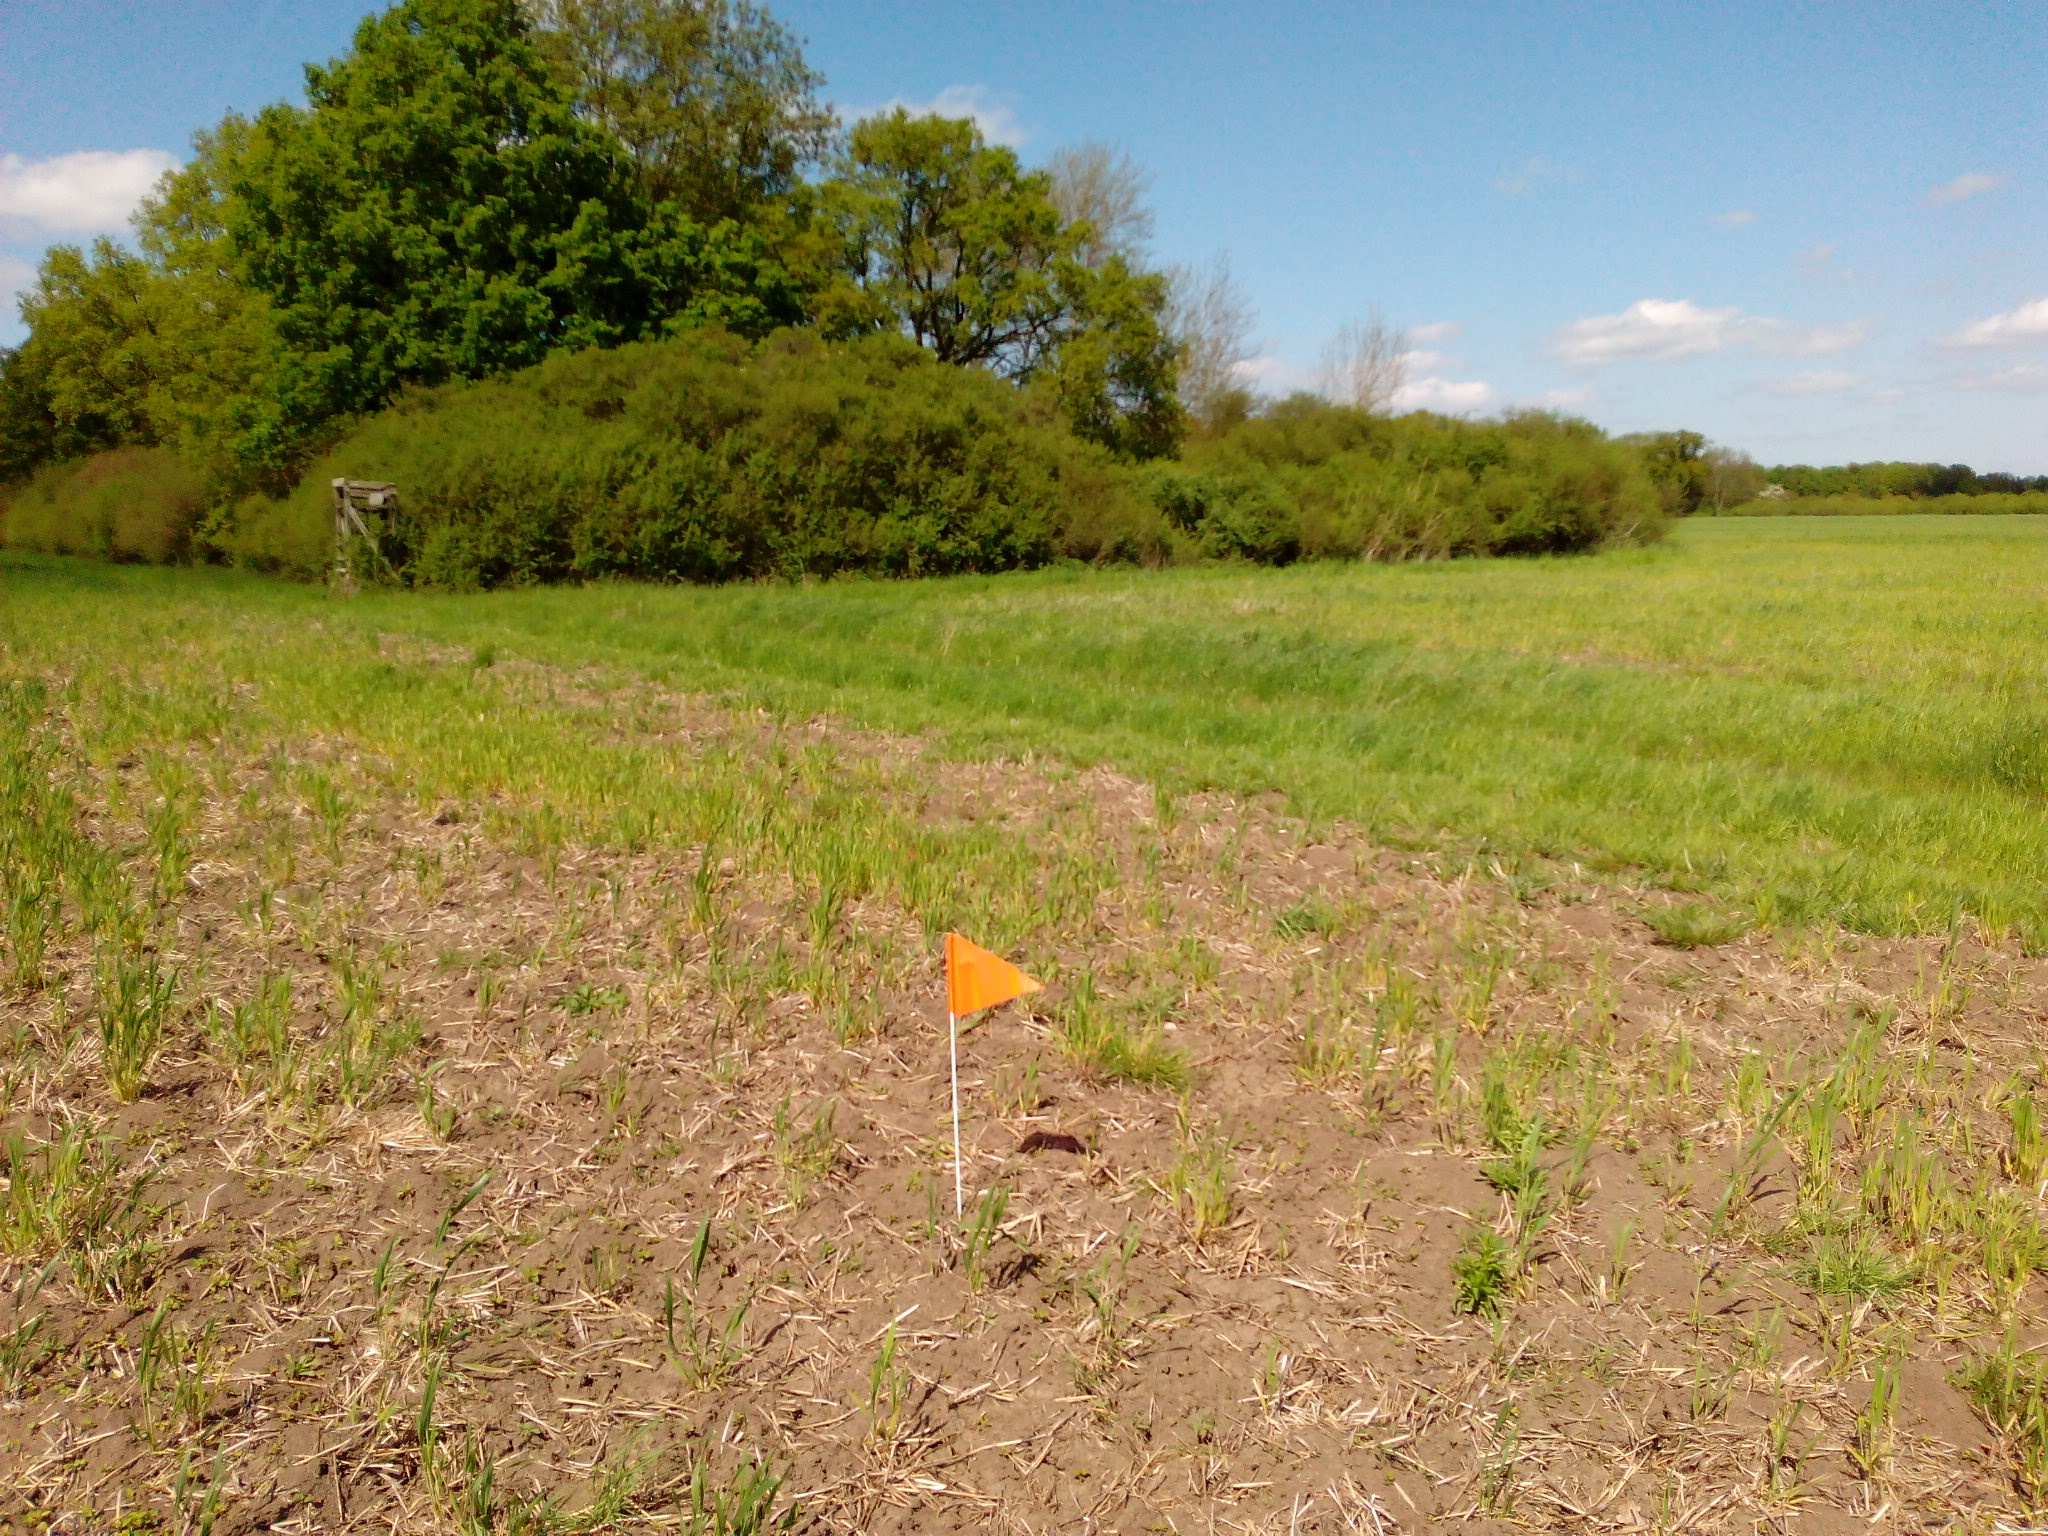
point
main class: Cropland
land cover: Triticale
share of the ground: < 10 %
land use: Agriculture (excluding fallow land and kitchen gardens)
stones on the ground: < 10 %
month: May
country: DE
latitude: 52.4493
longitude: 9.8676
